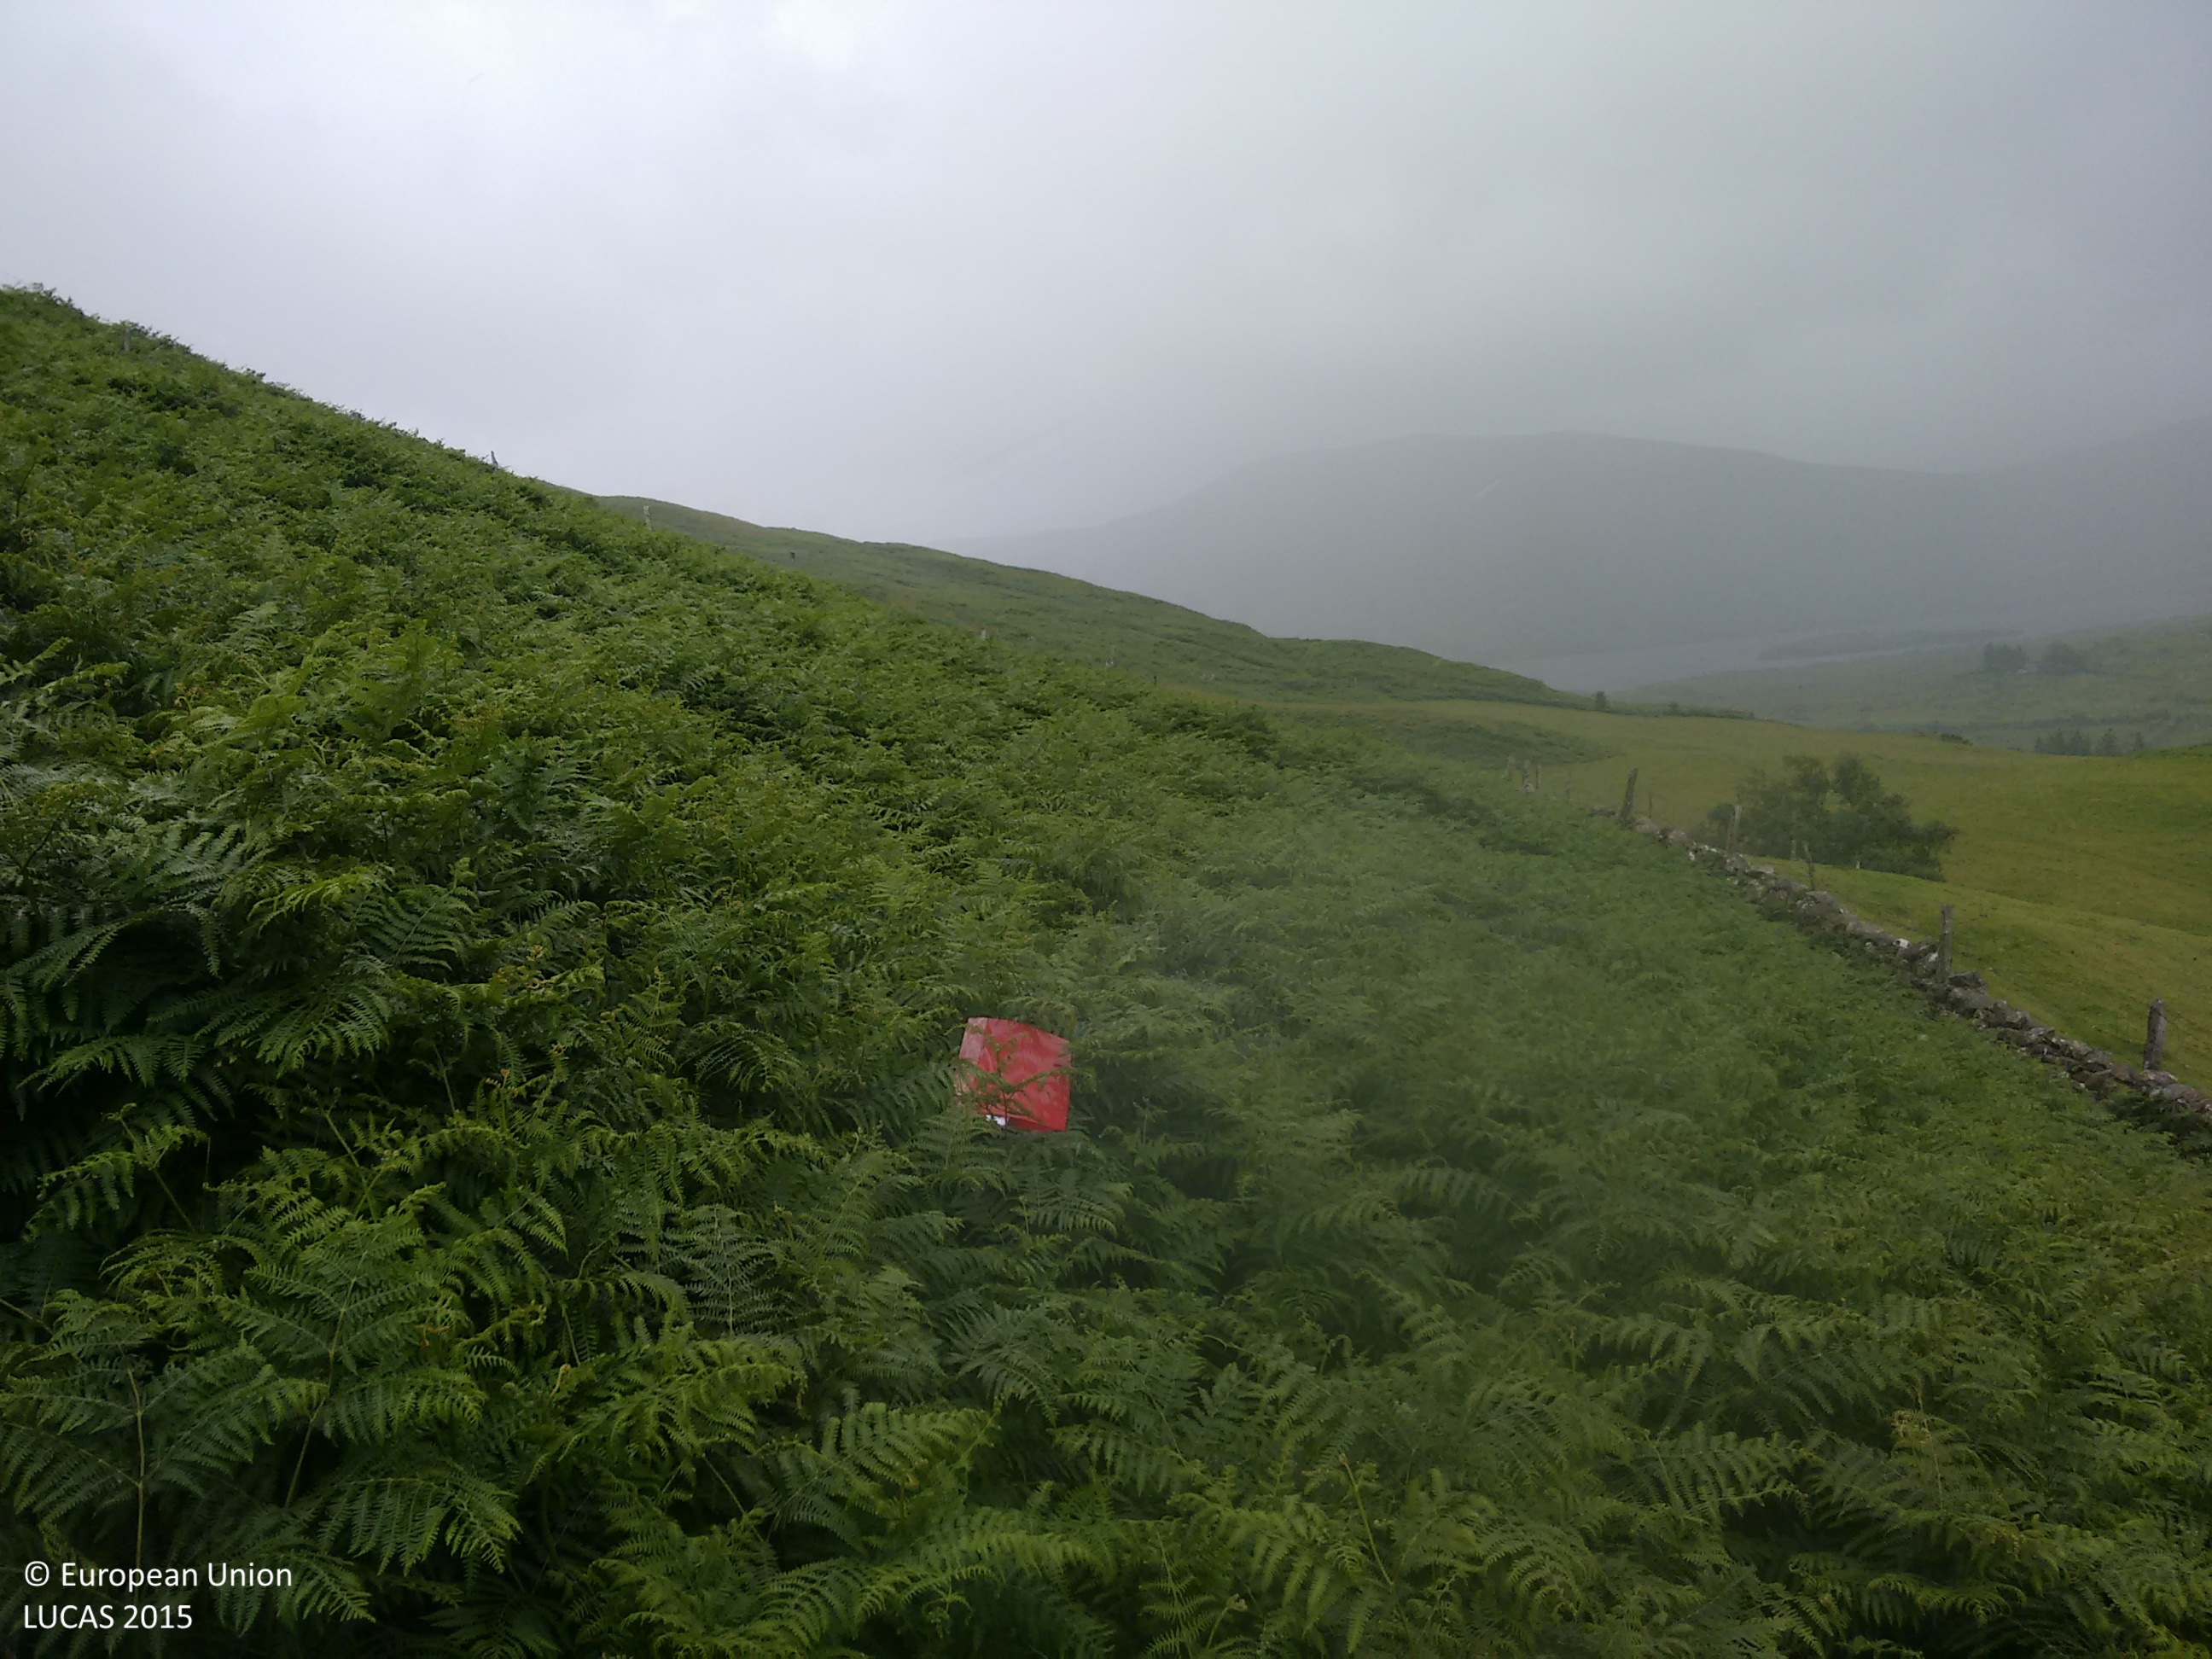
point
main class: Grassland
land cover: Spontaneously vegetated surfaces
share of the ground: > 75 %
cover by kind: herbaceous plants 100 %
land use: Semi-natural and natural areas not in use
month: July
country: IE
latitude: 53.5749
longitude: -9.4871
